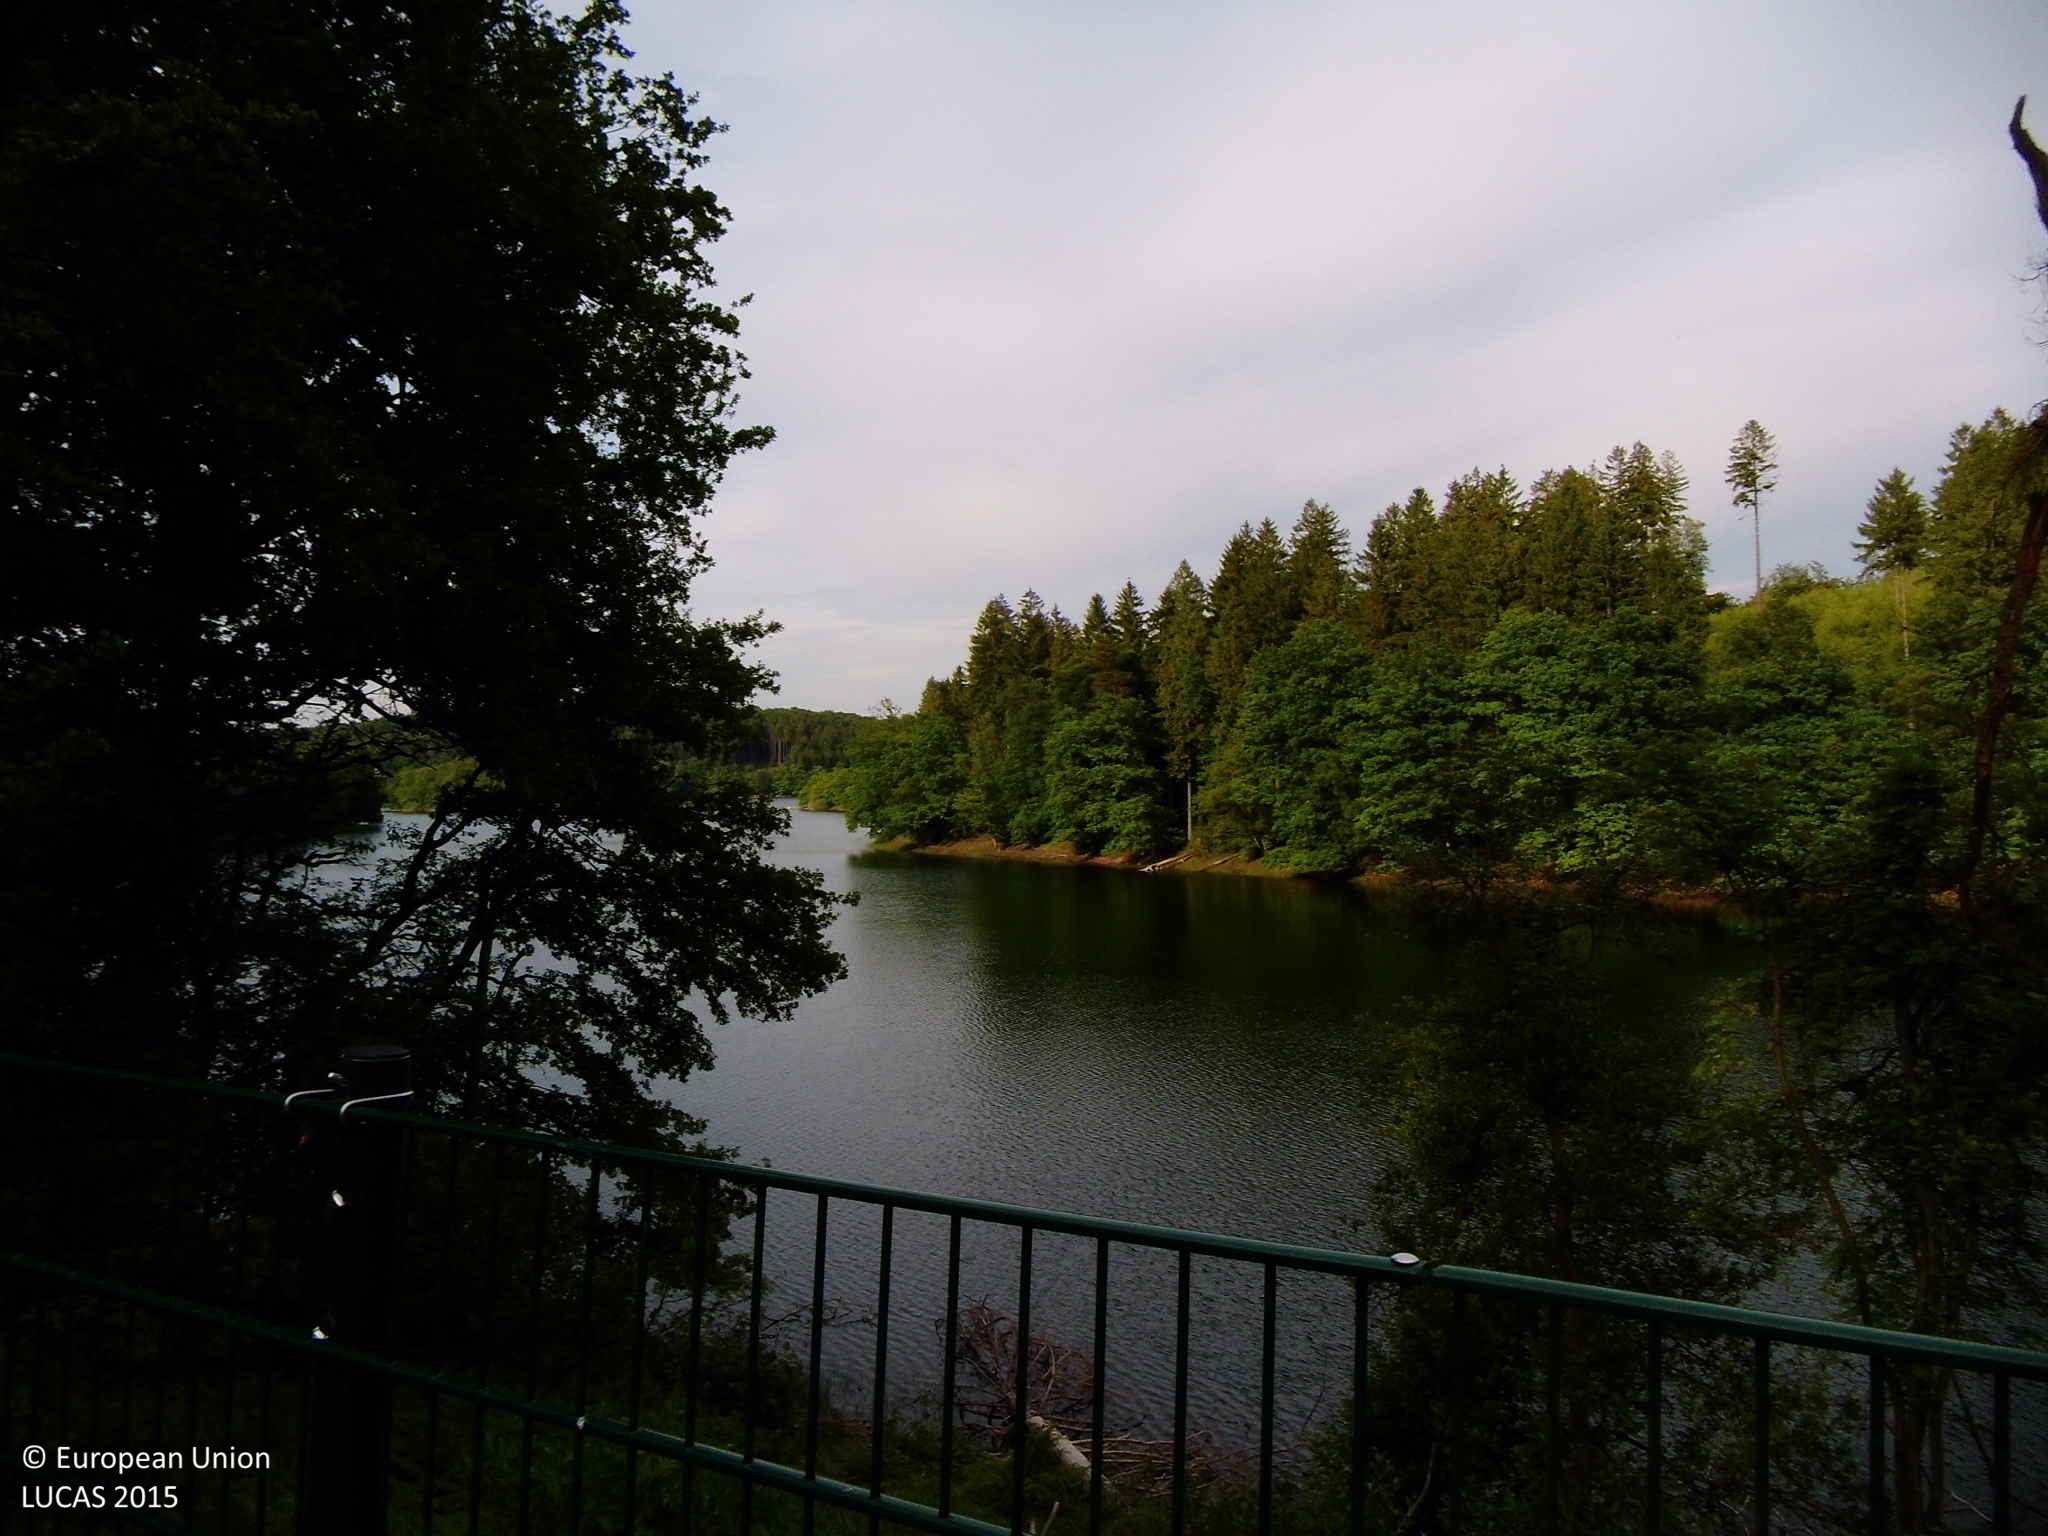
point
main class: Woodland
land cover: Spruce dominated mixed woodland
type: hemiboreal forest and nemoral coniferous forest and mixed broadleaved-coniferous forest
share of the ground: > 75 %
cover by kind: coniferous forest trees 40 %, broadleaved forest trees 35 %, herbaceous plants 10 %, unconsolidated bare surface 10 %, shrubs 5 %
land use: Forestry
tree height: > 5 m
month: June
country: DE
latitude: 51.2341
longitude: 7.4079
